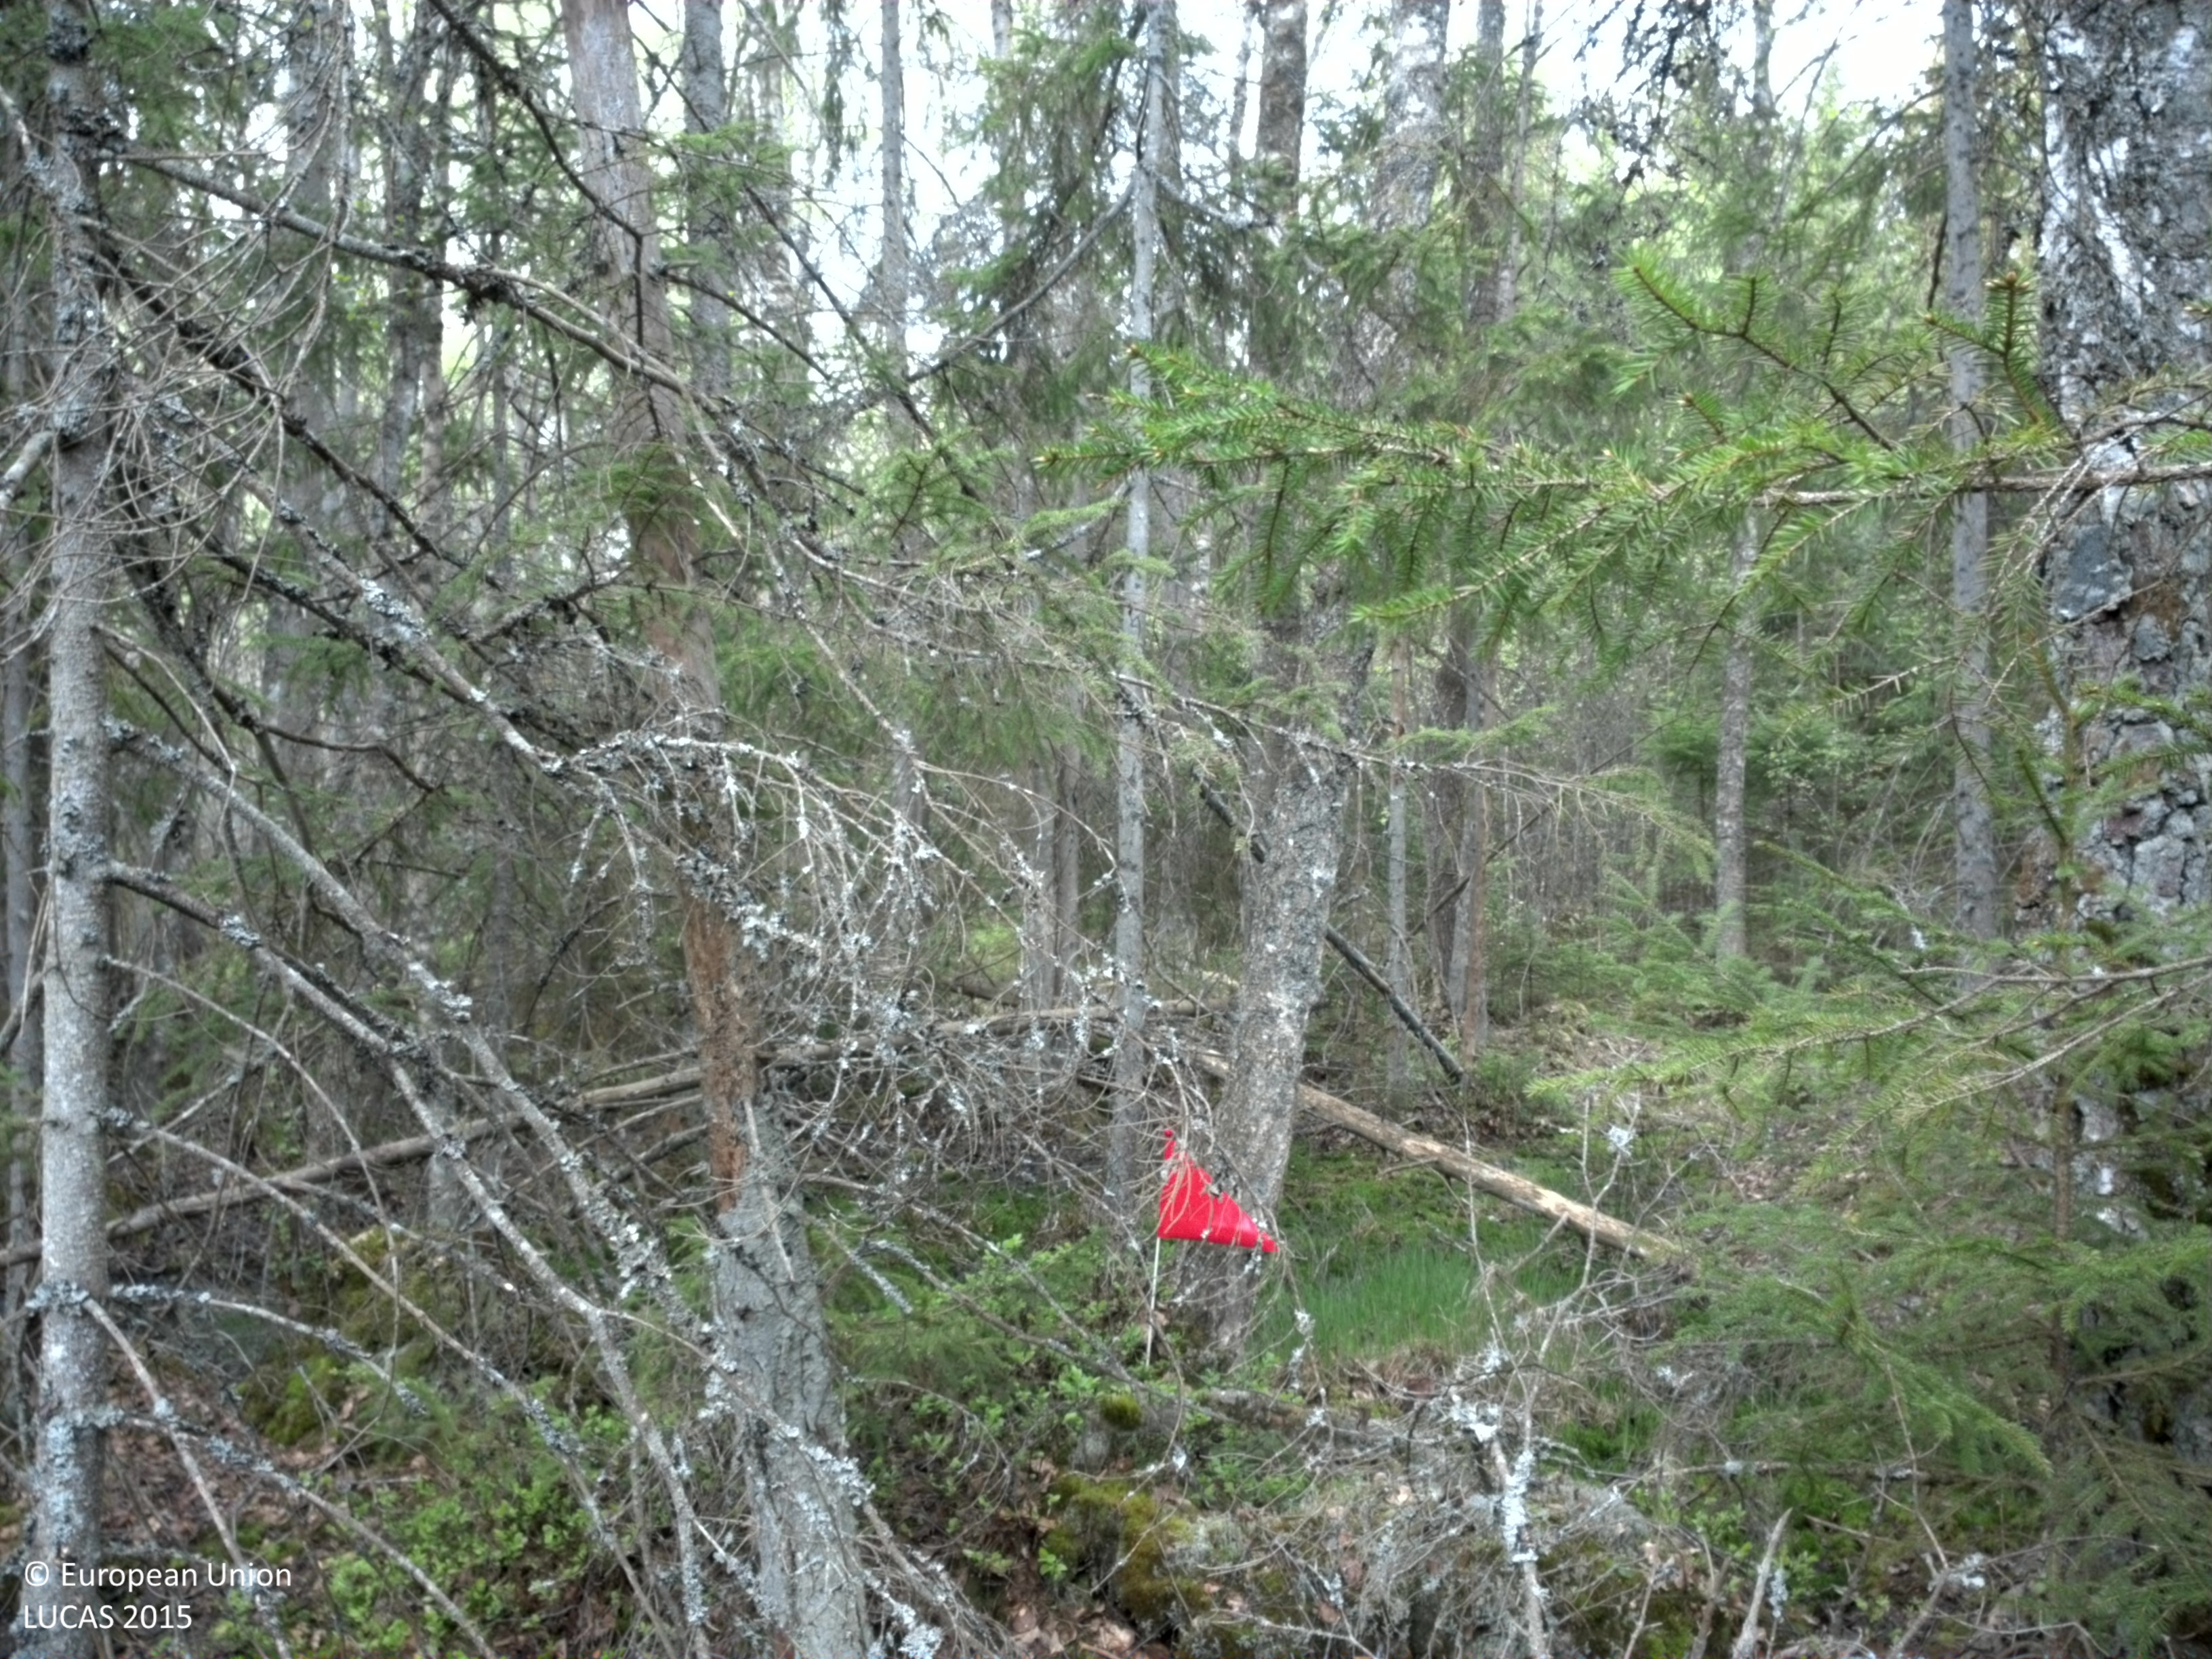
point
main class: Woodland
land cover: Spruce dominated mixed woodland
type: boreal forest
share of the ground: > 75 %
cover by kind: broadleaved forest trees 45 %, coniferous forest trees 35 %, lichens and mosses 20 %
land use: Forestry
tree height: > 5 m
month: May
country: SE
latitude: 56.7153
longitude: 15.1444
